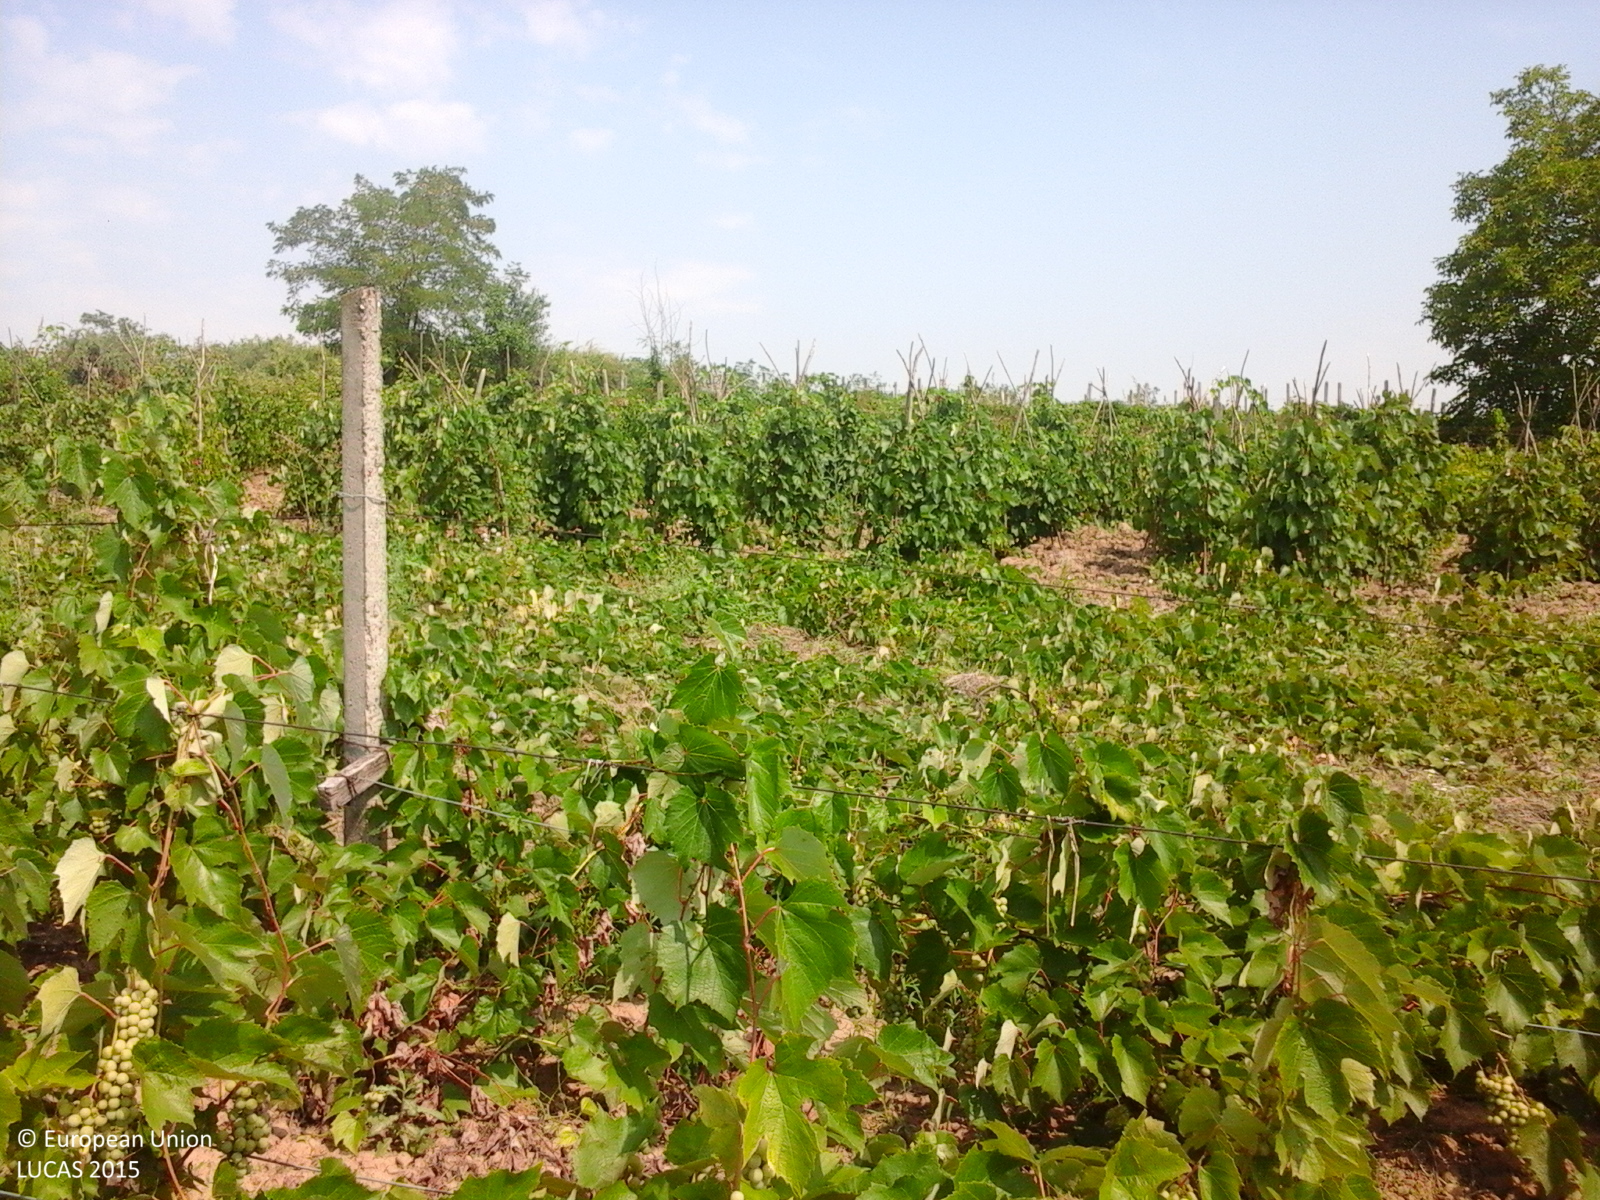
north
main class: Cropland
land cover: Vineyards
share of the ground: > 75 %
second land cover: Other bare soil
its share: > 75 %
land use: Agriculture (excluding fallow land and kitchen gardens)
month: August
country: RO
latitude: 46.1827
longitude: 27.0533
